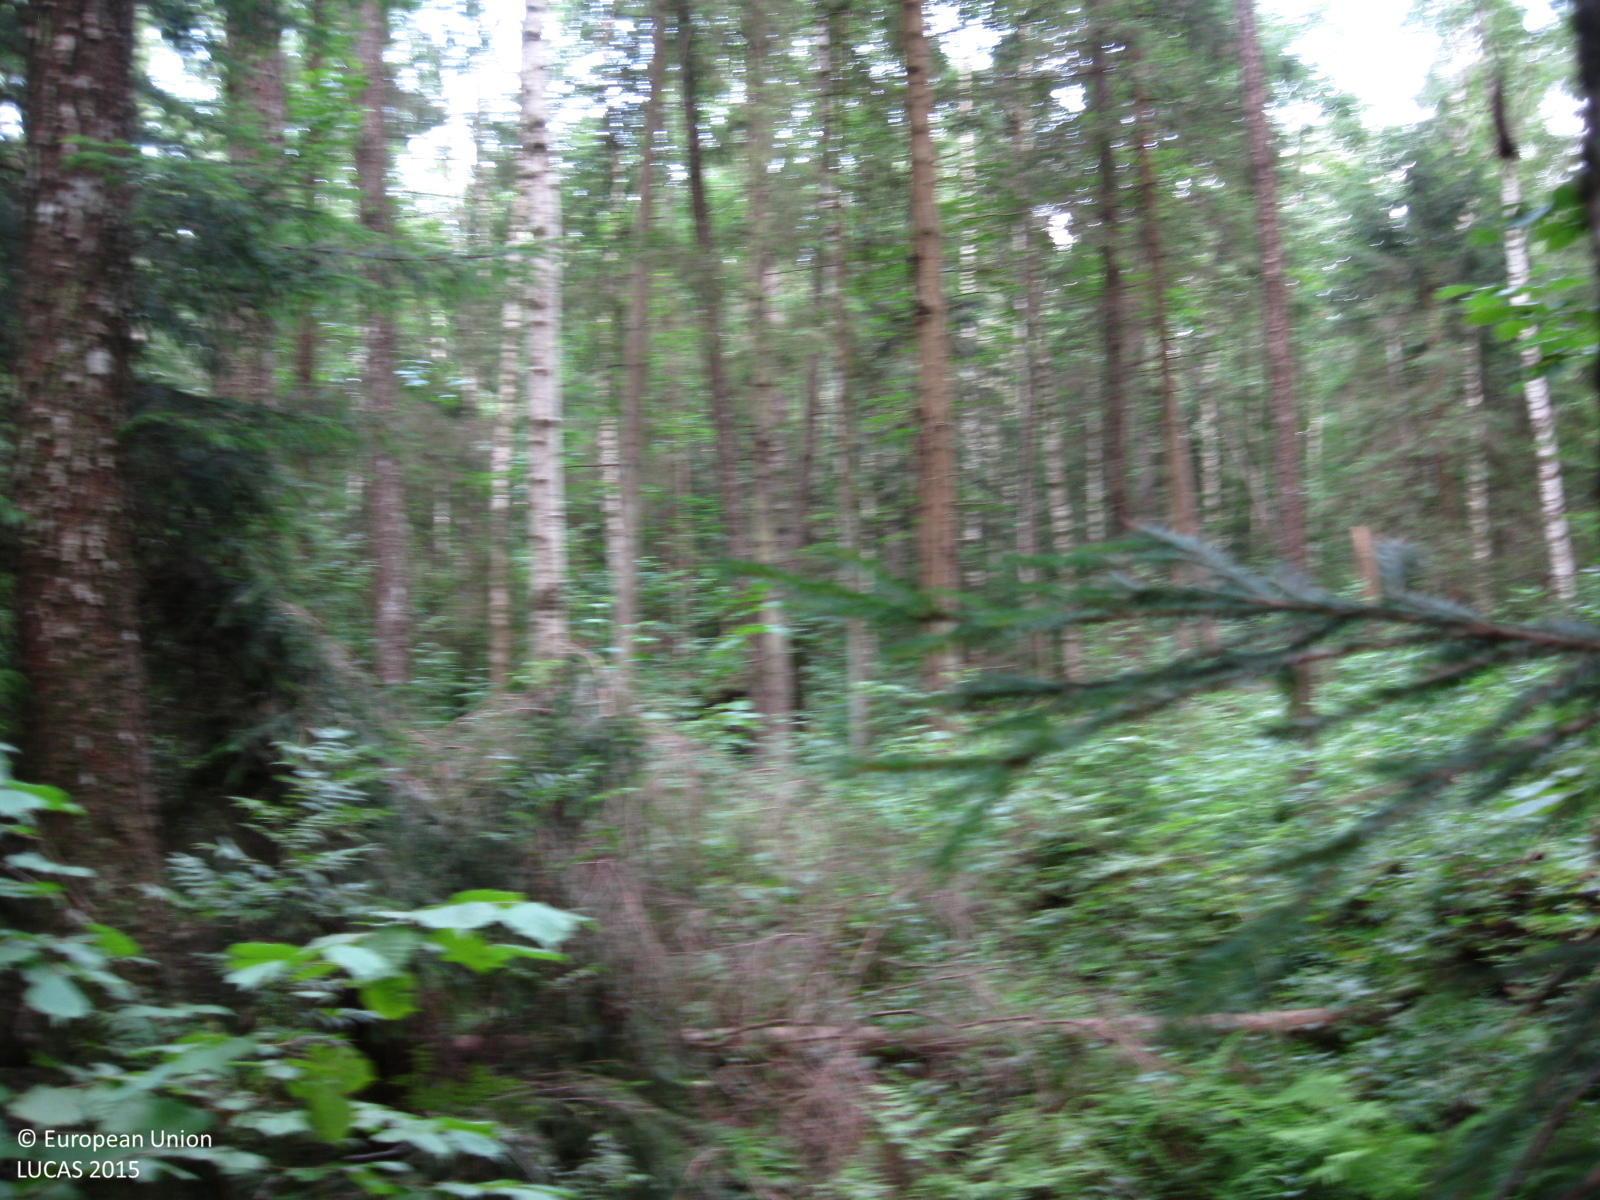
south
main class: Woodland
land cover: Spruce dominated mixed woodland
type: hemiboreal forest and nemoral coniferous forest and mixed broadleaved-coniferous forest
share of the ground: > 75 %
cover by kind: coniferous forest trees 45 %, broadleaved forest trees 35 %, herbaceous plants 10 %, shrubs 5 %, unconsolidated bare surface 5 %
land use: Forestry
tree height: > 5 m
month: July
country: LT
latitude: 55.3995
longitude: 24.6145
